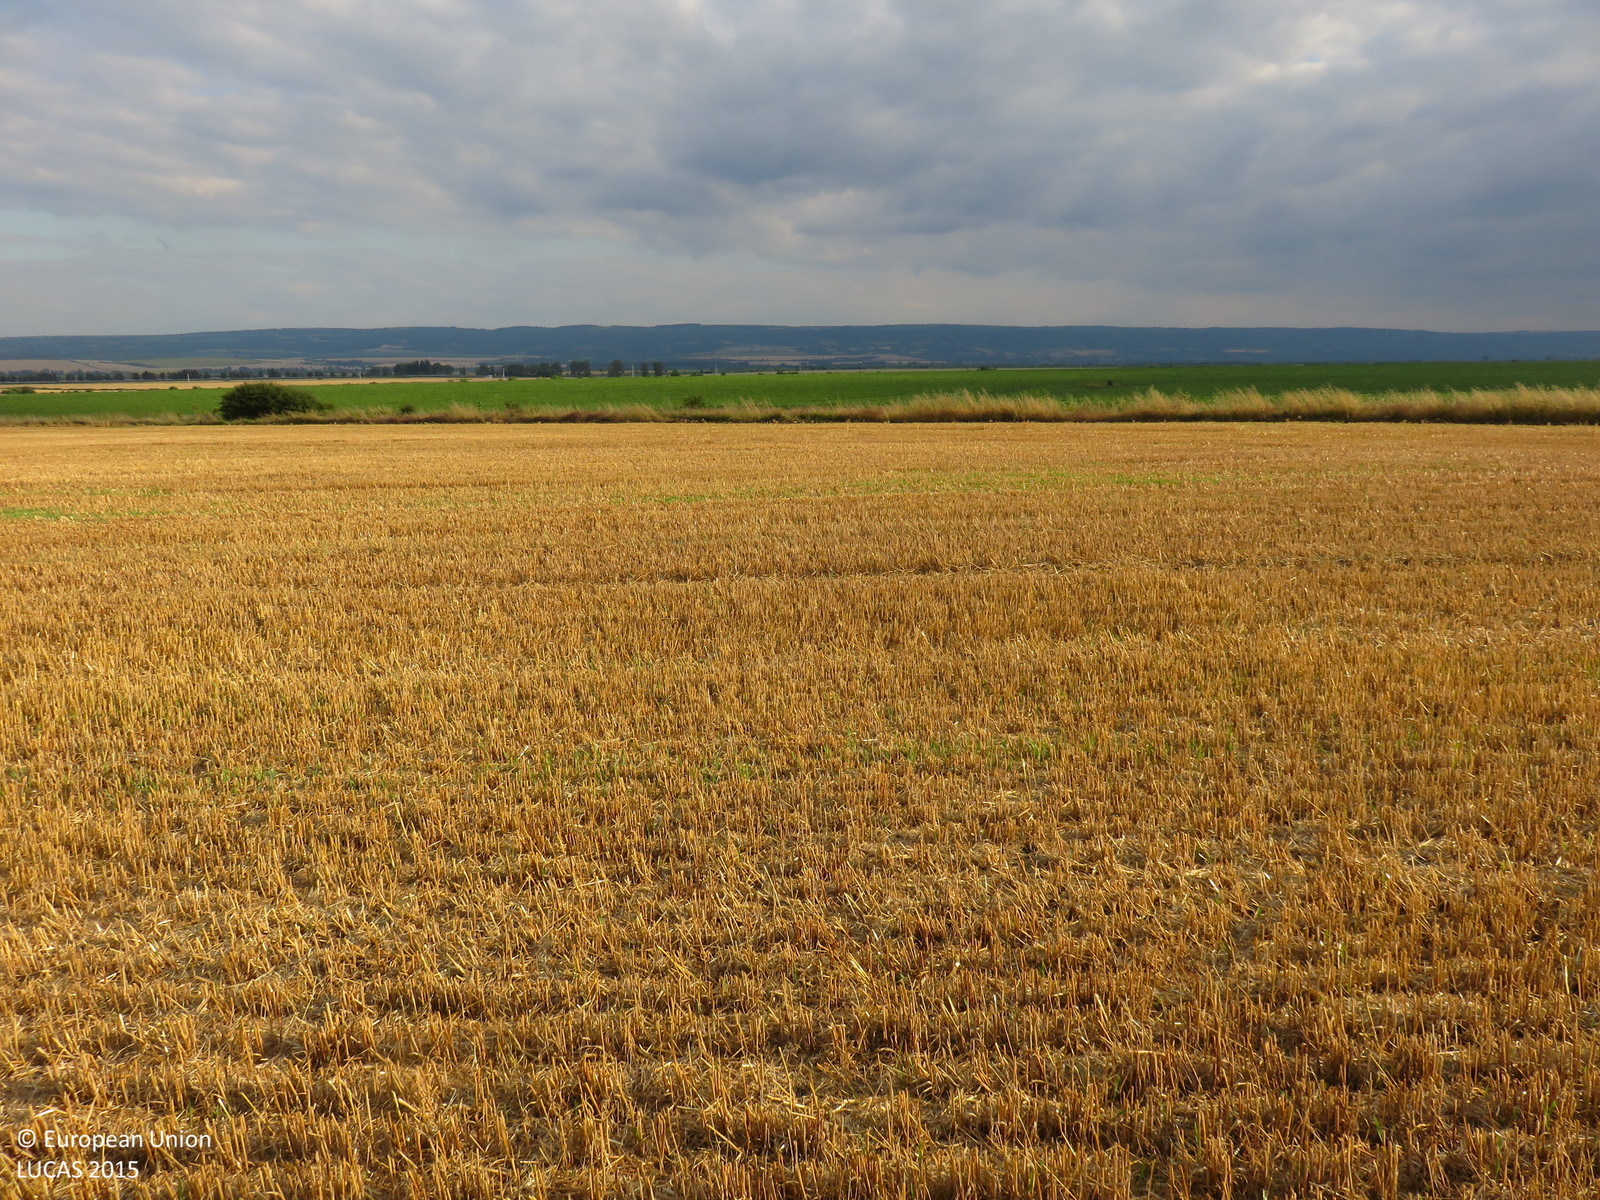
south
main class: Cropland
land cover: Barley
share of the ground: > 75 %
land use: Agriculture (excluding fallow land and kitchen gardens)
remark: Harvested field
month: June
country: BG
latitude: 43.3221
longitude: 25.0278
